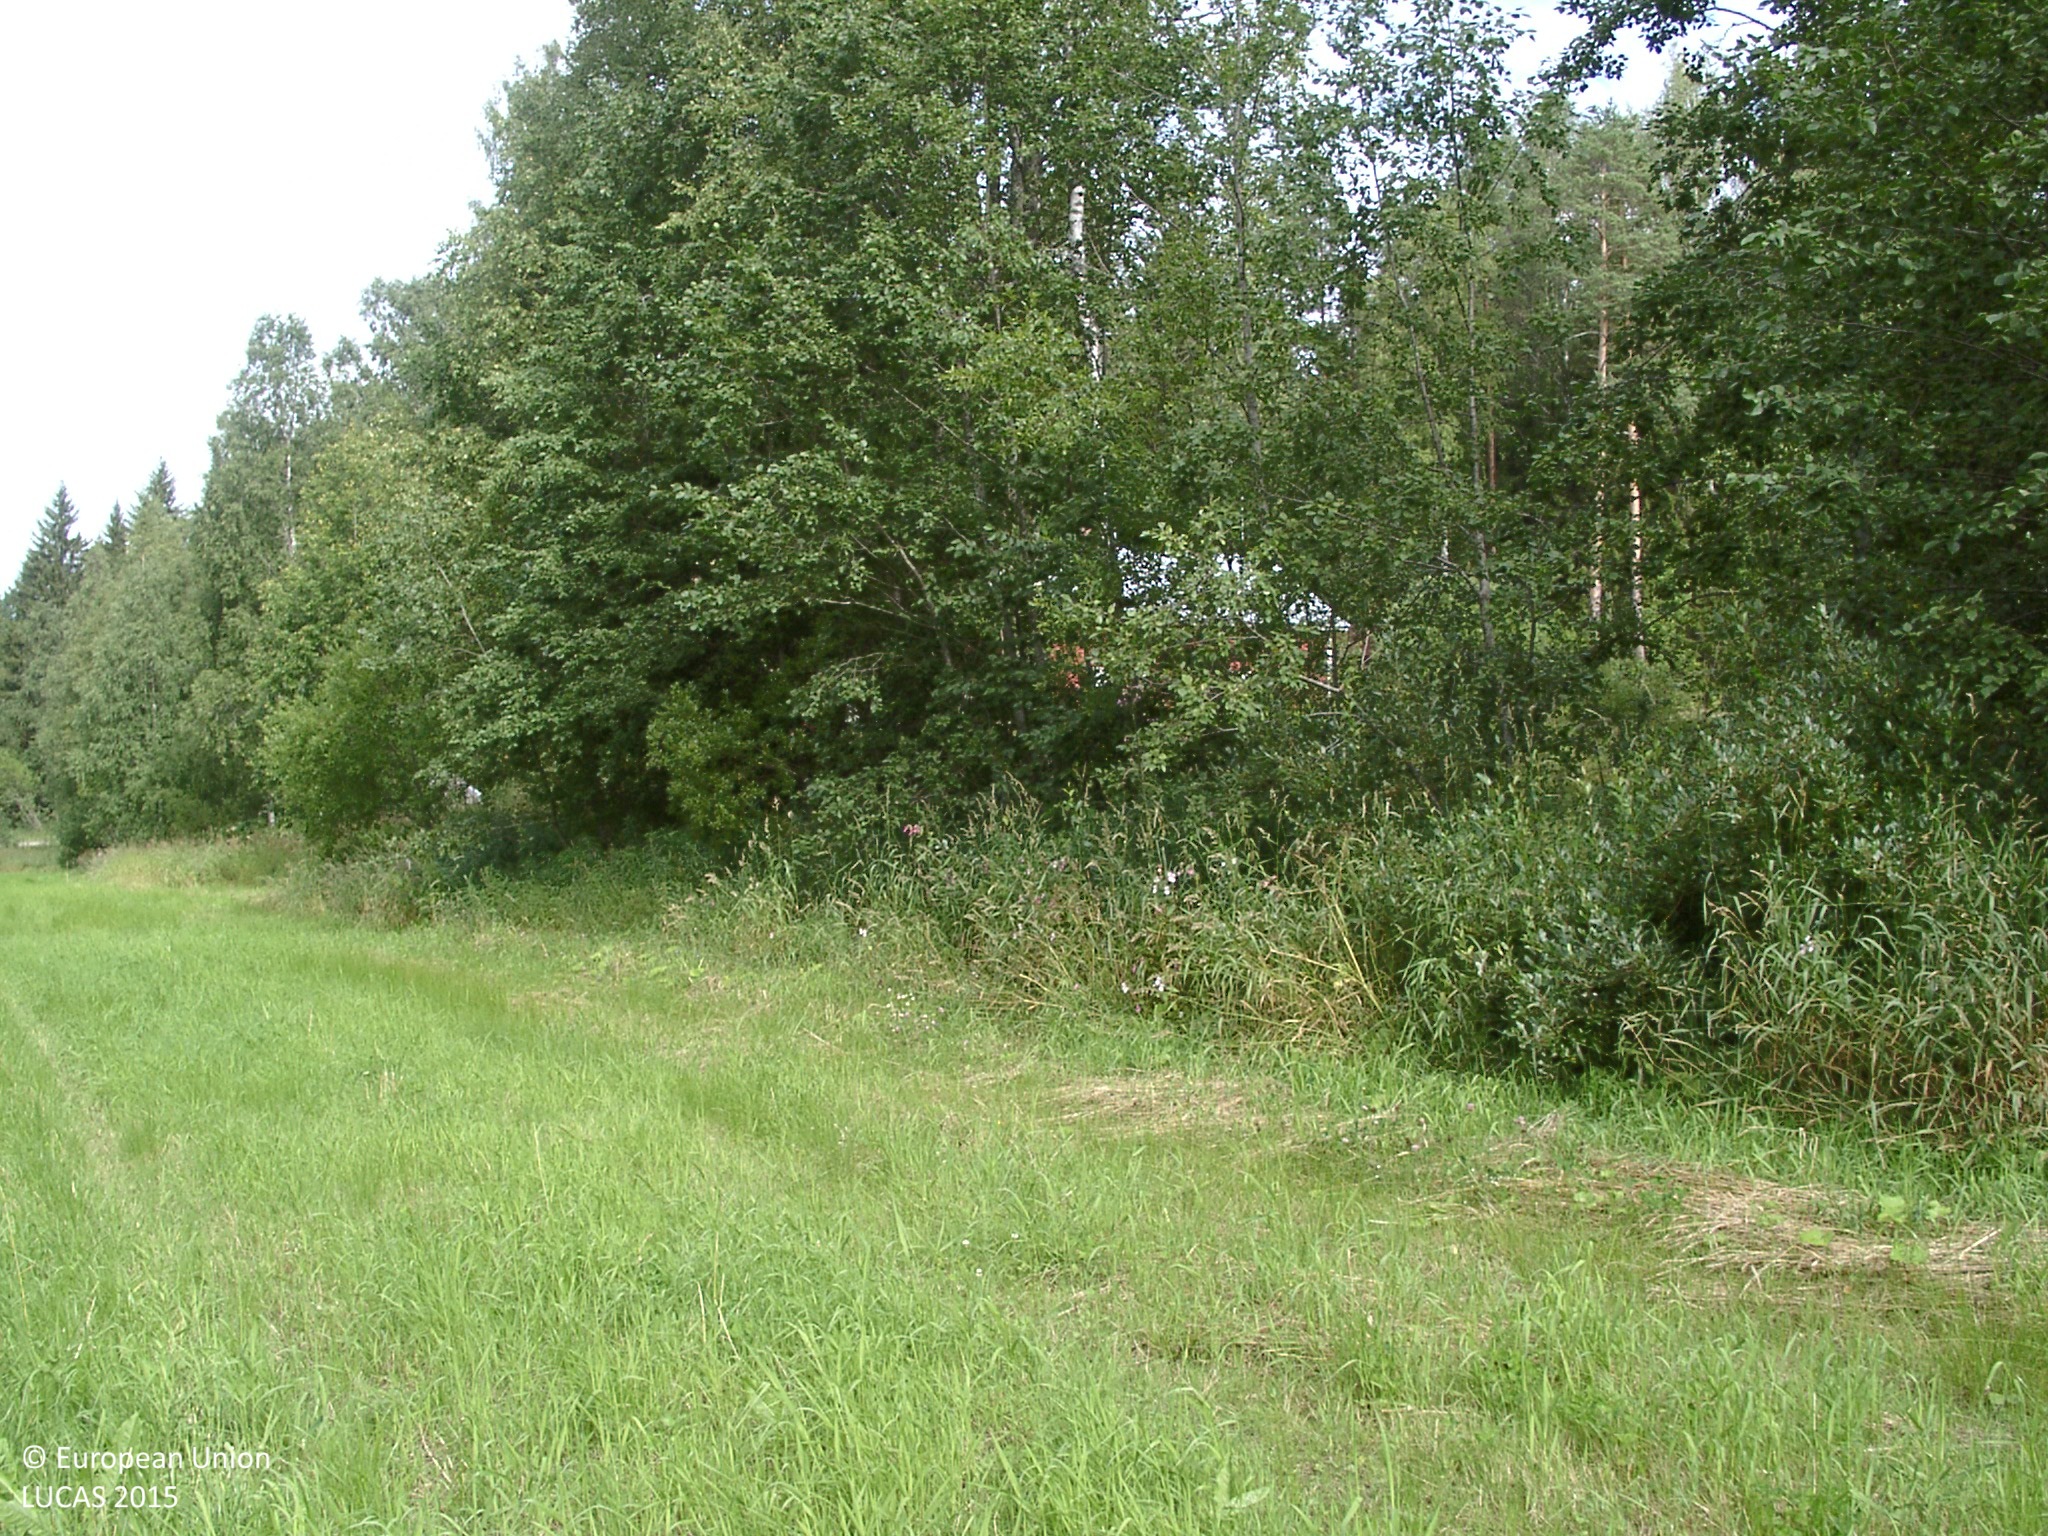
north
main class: Cropland
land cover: Temporary grasslands
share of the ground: > 75 %
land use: Agriculture (excluding fallow land and kitchen gardens)
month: August
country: FI
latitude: 62.4228
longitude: 25.3869
